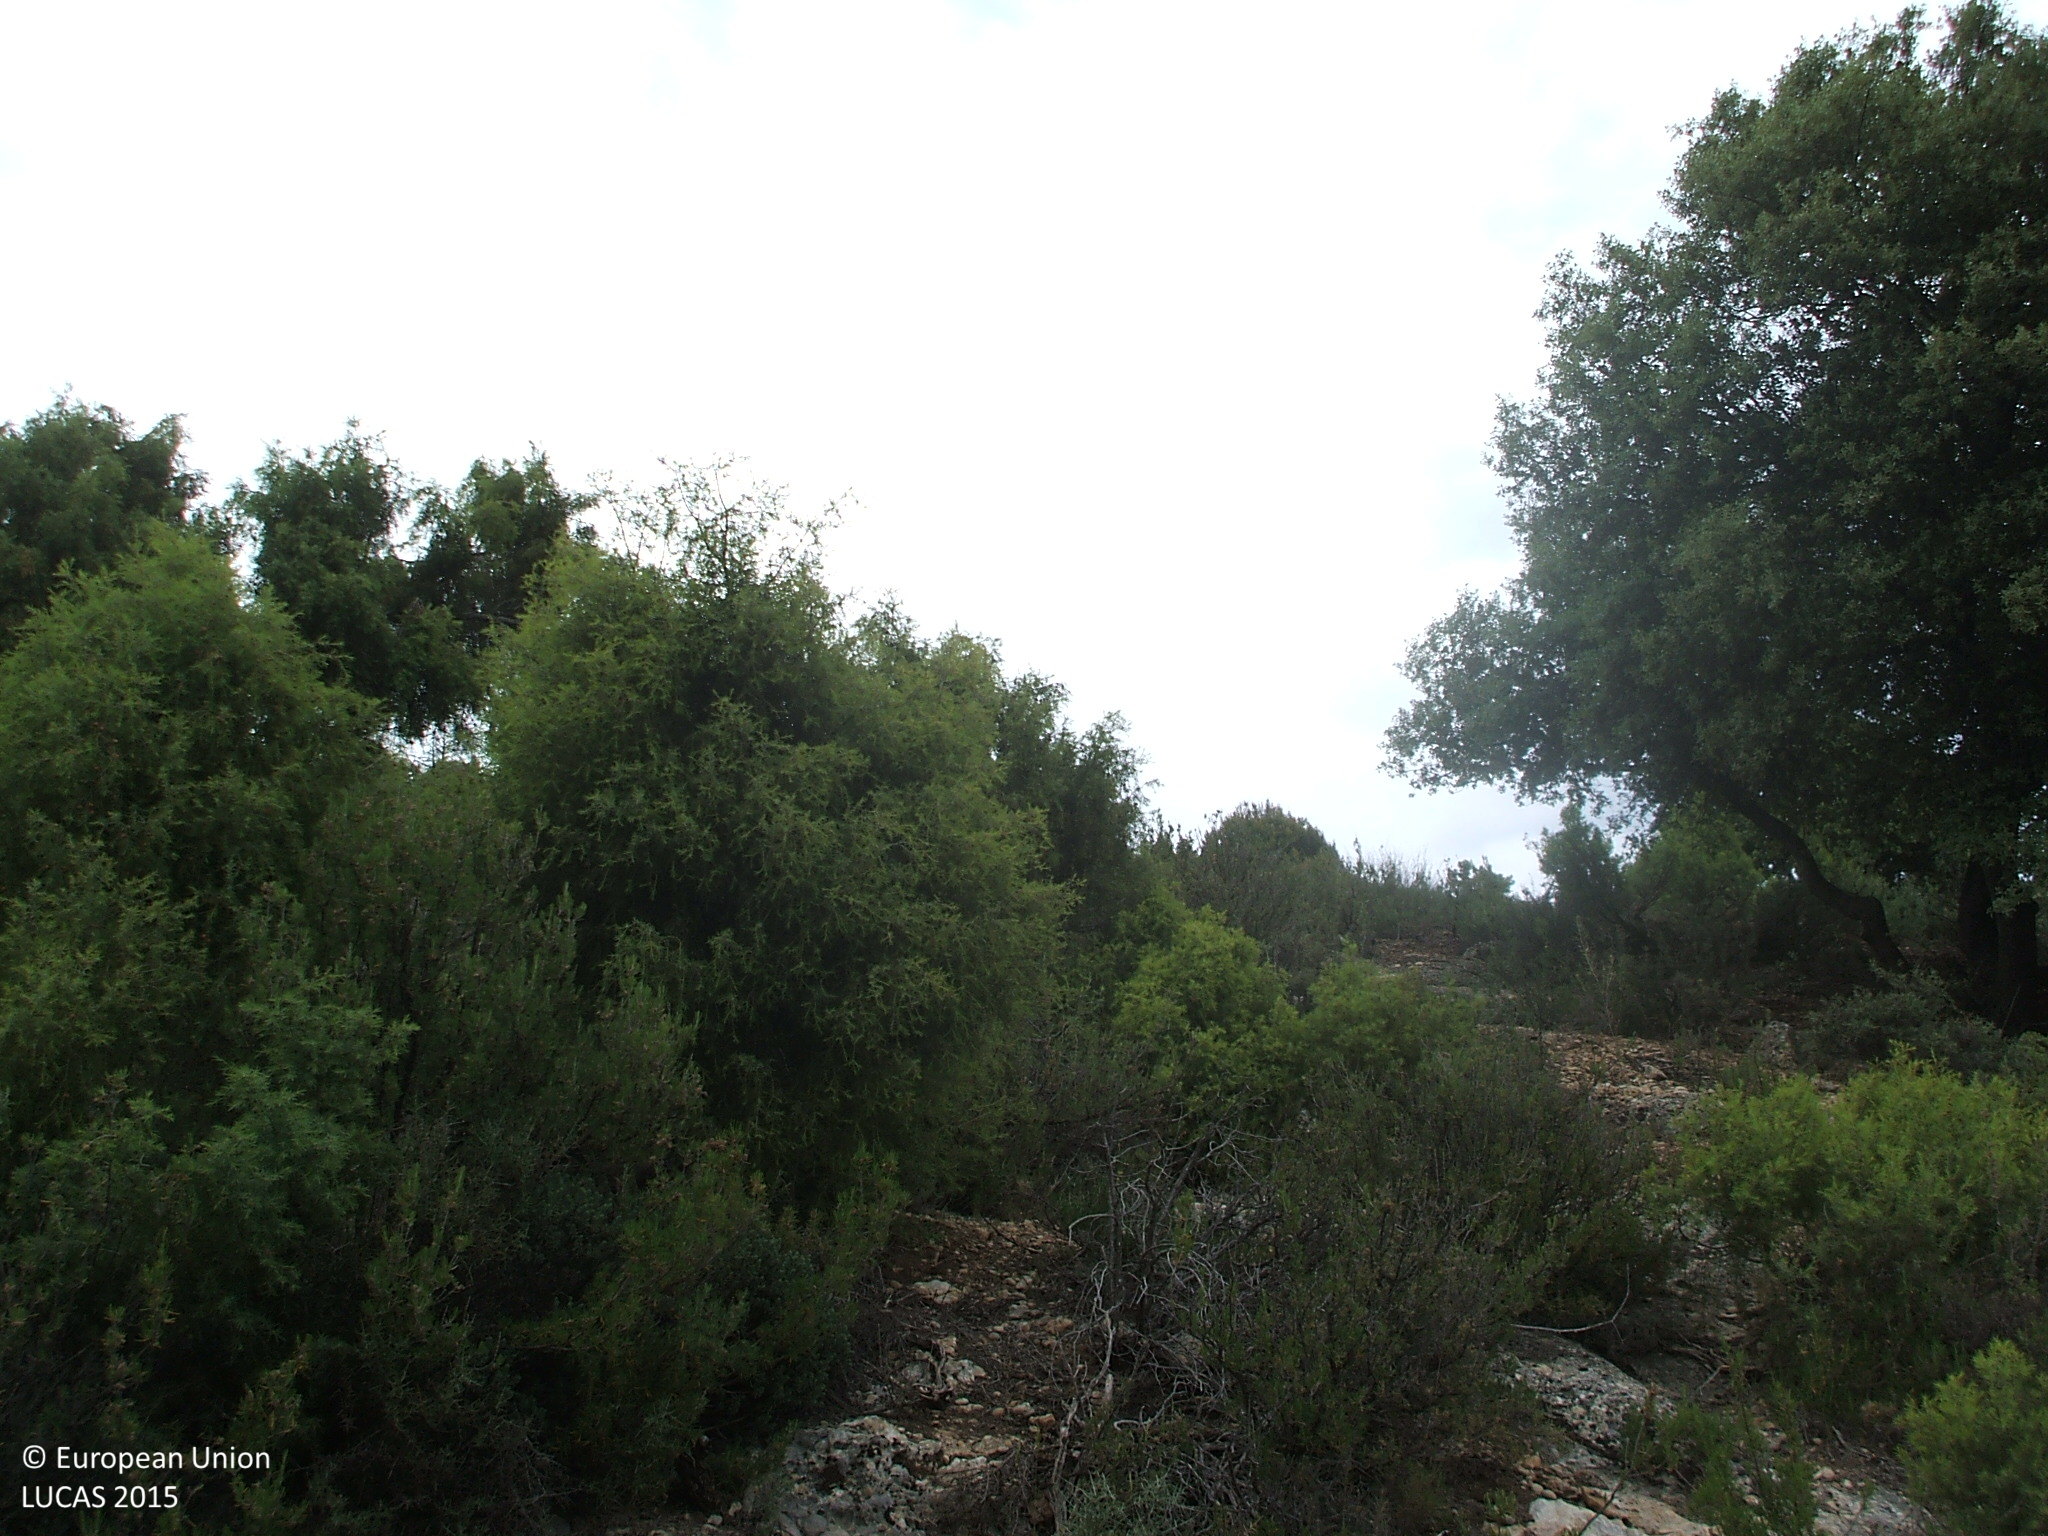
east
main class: Shrubland
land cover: Shrubland with sparse tree cover
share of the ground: 50 - 75 %
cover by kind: consolidated bare surface 55 %, shrubs 40 %, broadleaved forest trees 5 %
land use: Semi-natural and natural areas not in use
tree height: > 5 m
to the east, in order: Shrubland with sparse tree cover; Rocks and stones; Other mixed woodland; Tracks; Other mixed woodland; Rocks and stones; Tracks; Rocks and stones; Other mixed woodland
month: June
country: ES
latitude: 40.8424
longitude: -0.0548
